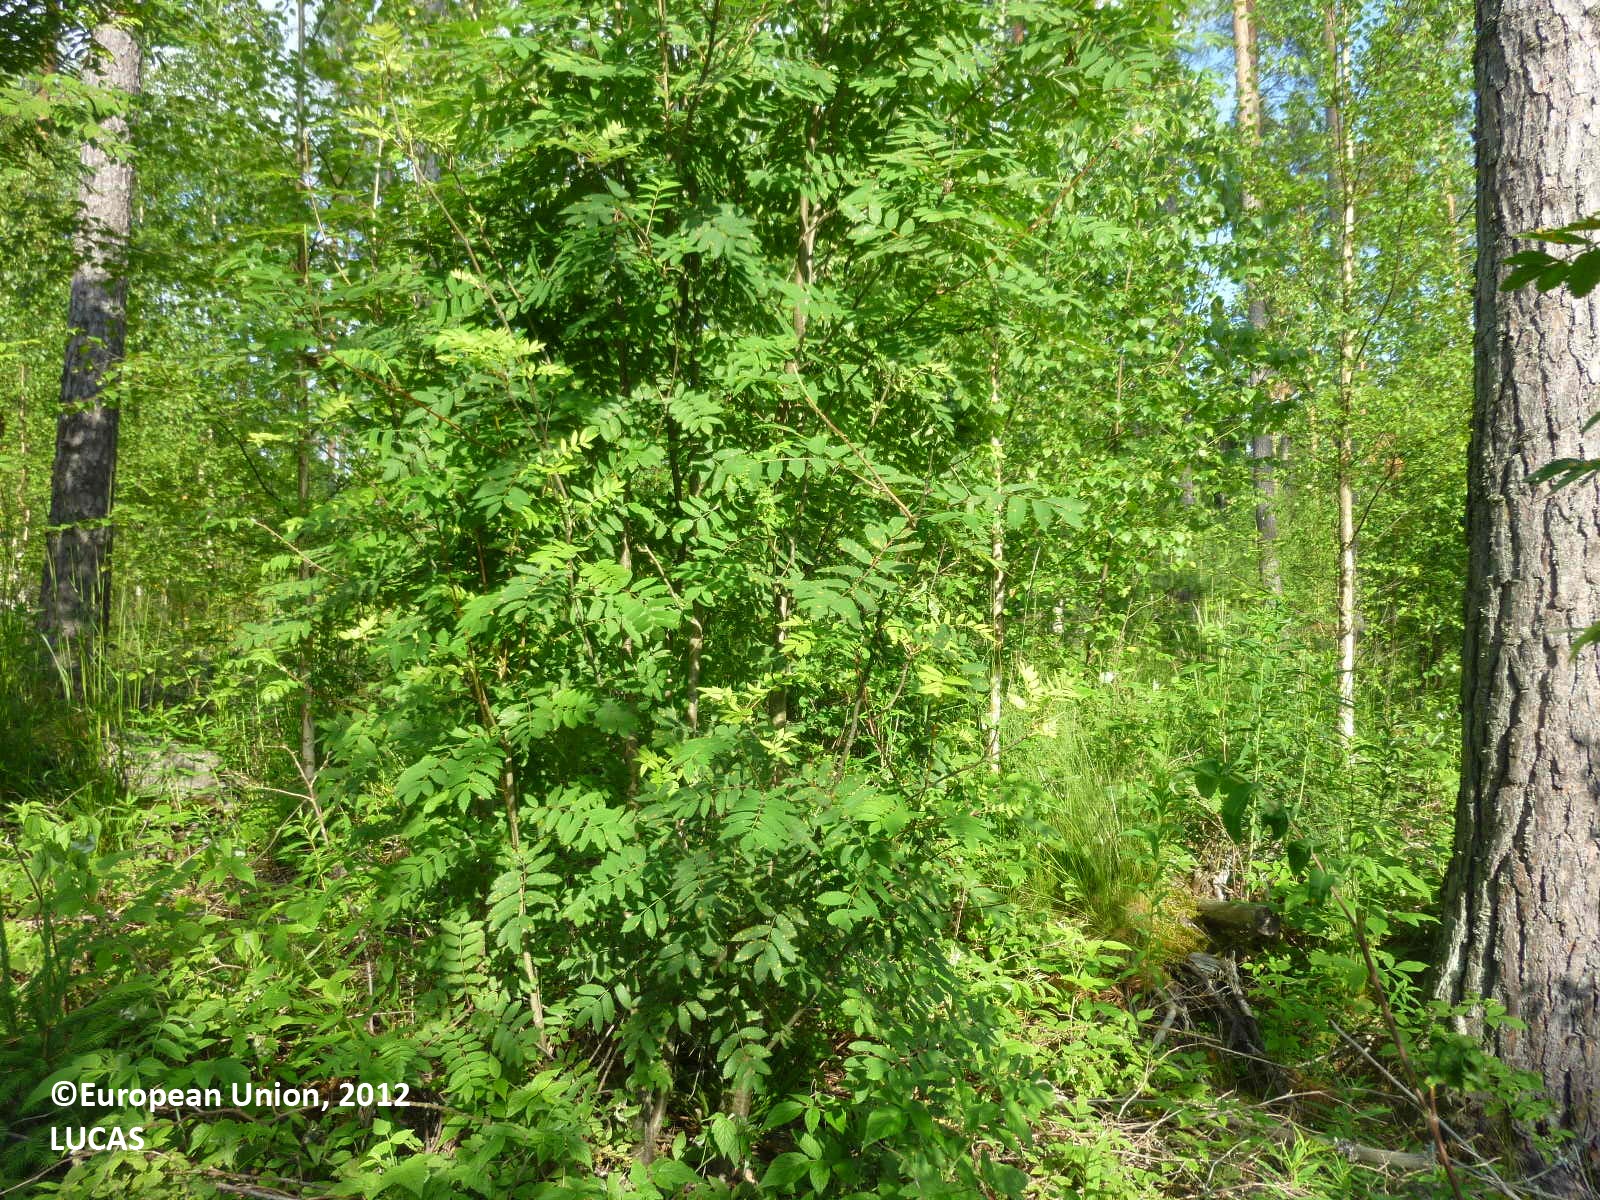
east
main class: Woodland
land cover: Pine dominated mixed woodland
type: boreal forest
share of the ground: 50 - 75 %
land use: Forestry
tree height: > 5 m
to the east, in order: Pine dominated mixed woodland; Electric lines; Pine dominated mixed woodland; Grassland without tree/shrub cover; Paved roads, cycling and walking lanes; Grass margins; Spruce dominated coniferous woodland; Shrubland without tree cover; Electric lines; Shrubland without tree cover; Broadleaved woodland
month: July
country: FI
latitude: 61.3878
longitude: 22.3609
